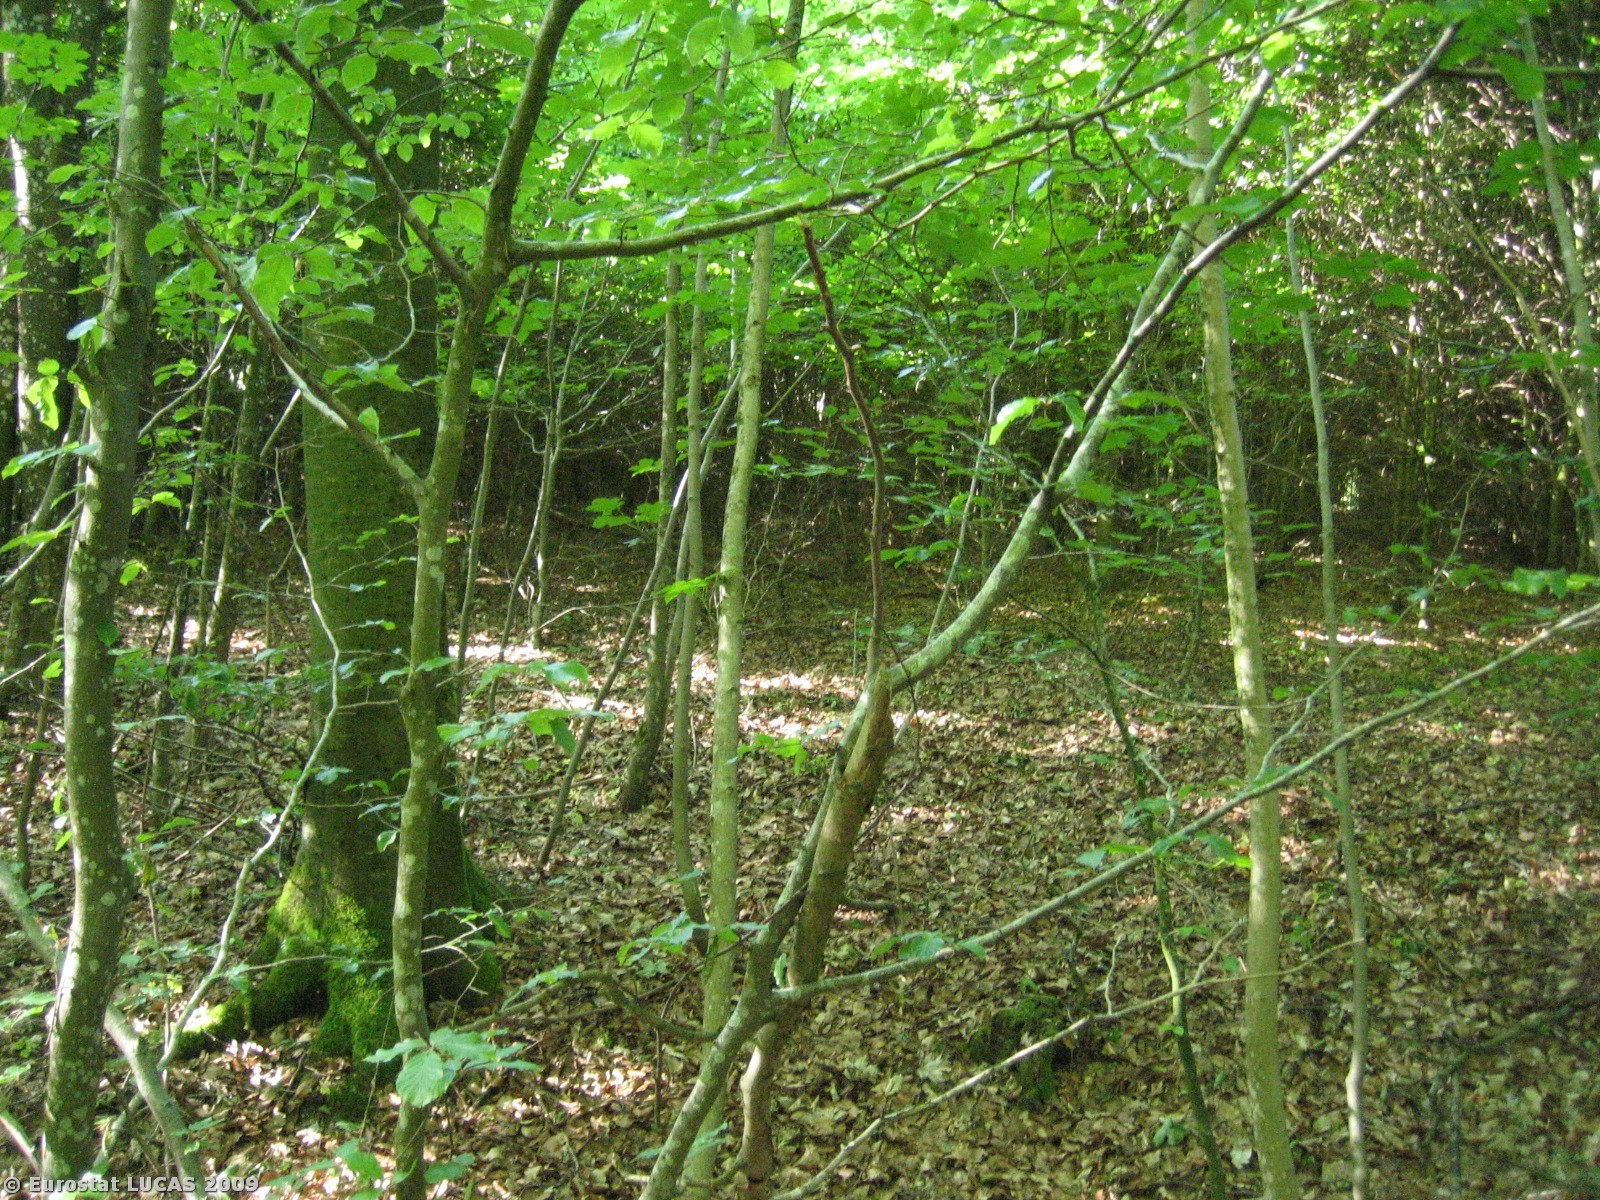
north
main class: Woodland
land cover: Broadleaved woodland
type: mesophytic deciduous forest
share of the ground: > 75 %
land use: Forestry
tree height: > 5 m
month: June
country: DK
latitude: 55.8101
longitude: 9.7928
